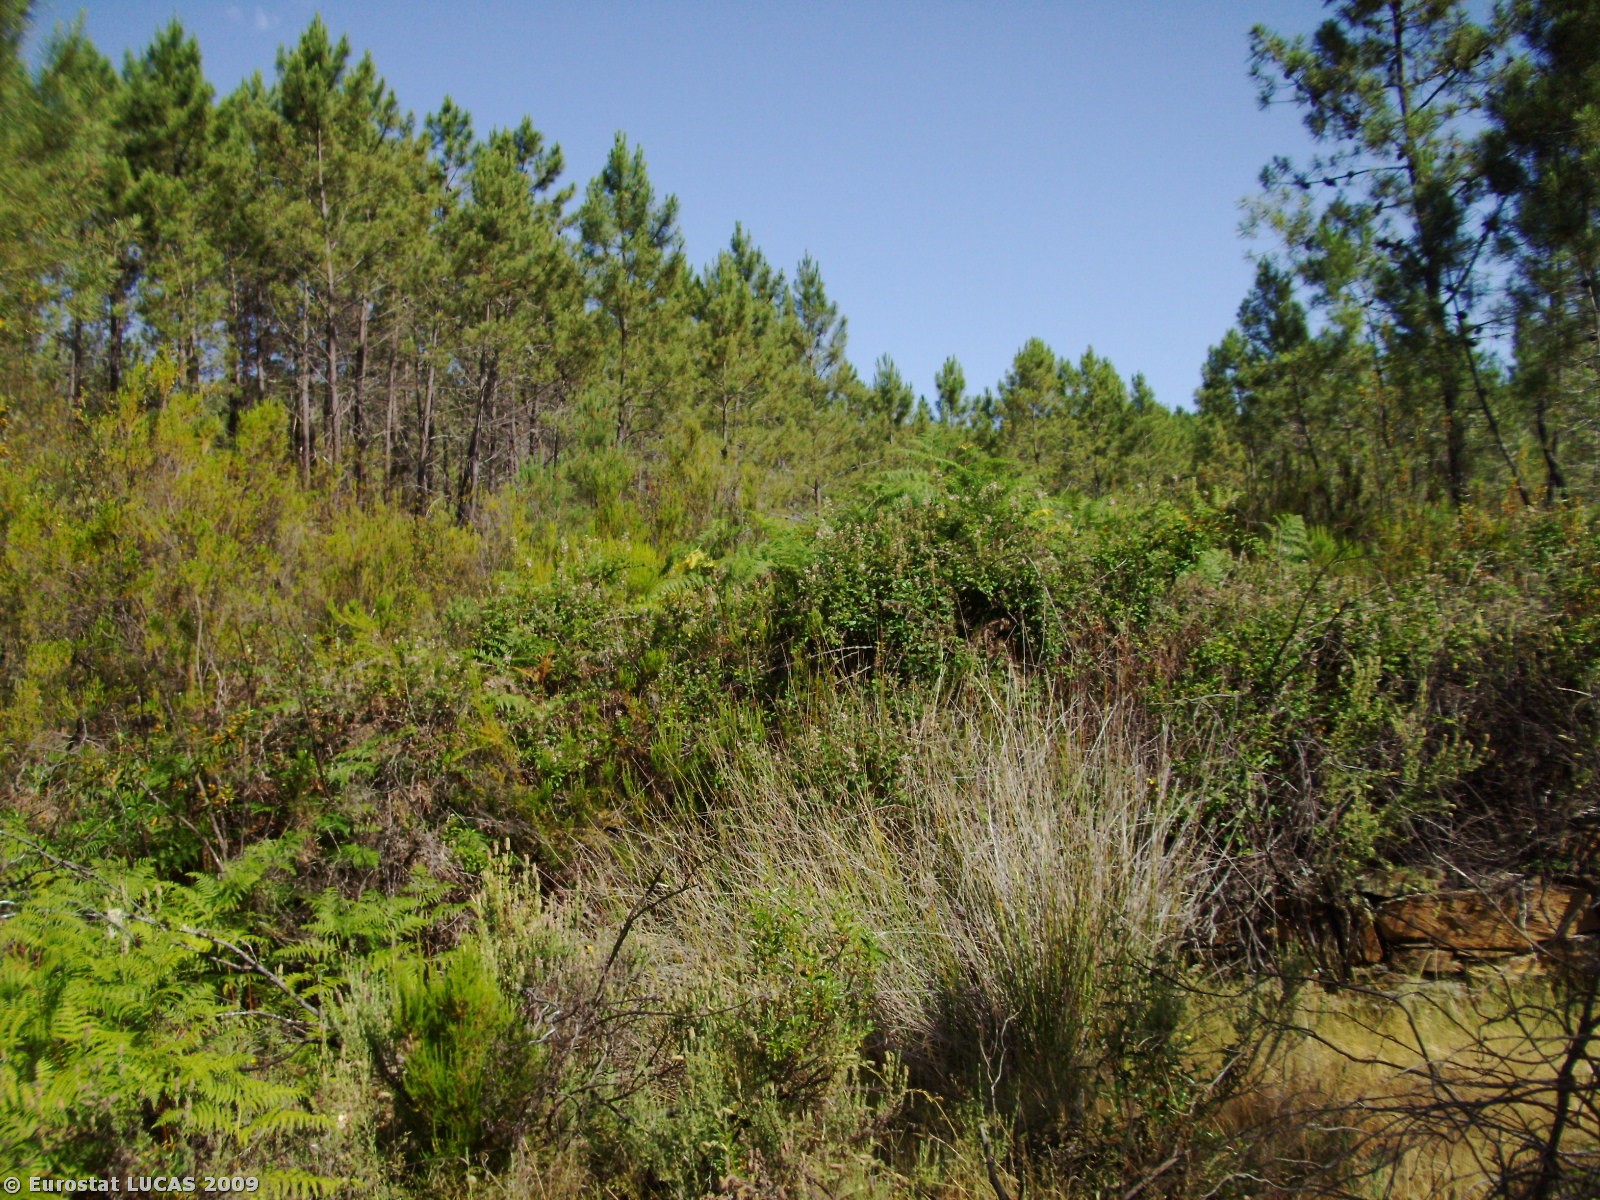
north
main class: Woodland
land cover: Coniferous woodland
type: coniferous forest of the mediterranean region
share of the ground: > 75 %
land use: Forestry
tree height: > 5 m
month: June
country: PT
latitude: 39.9672
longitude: -7.6314
